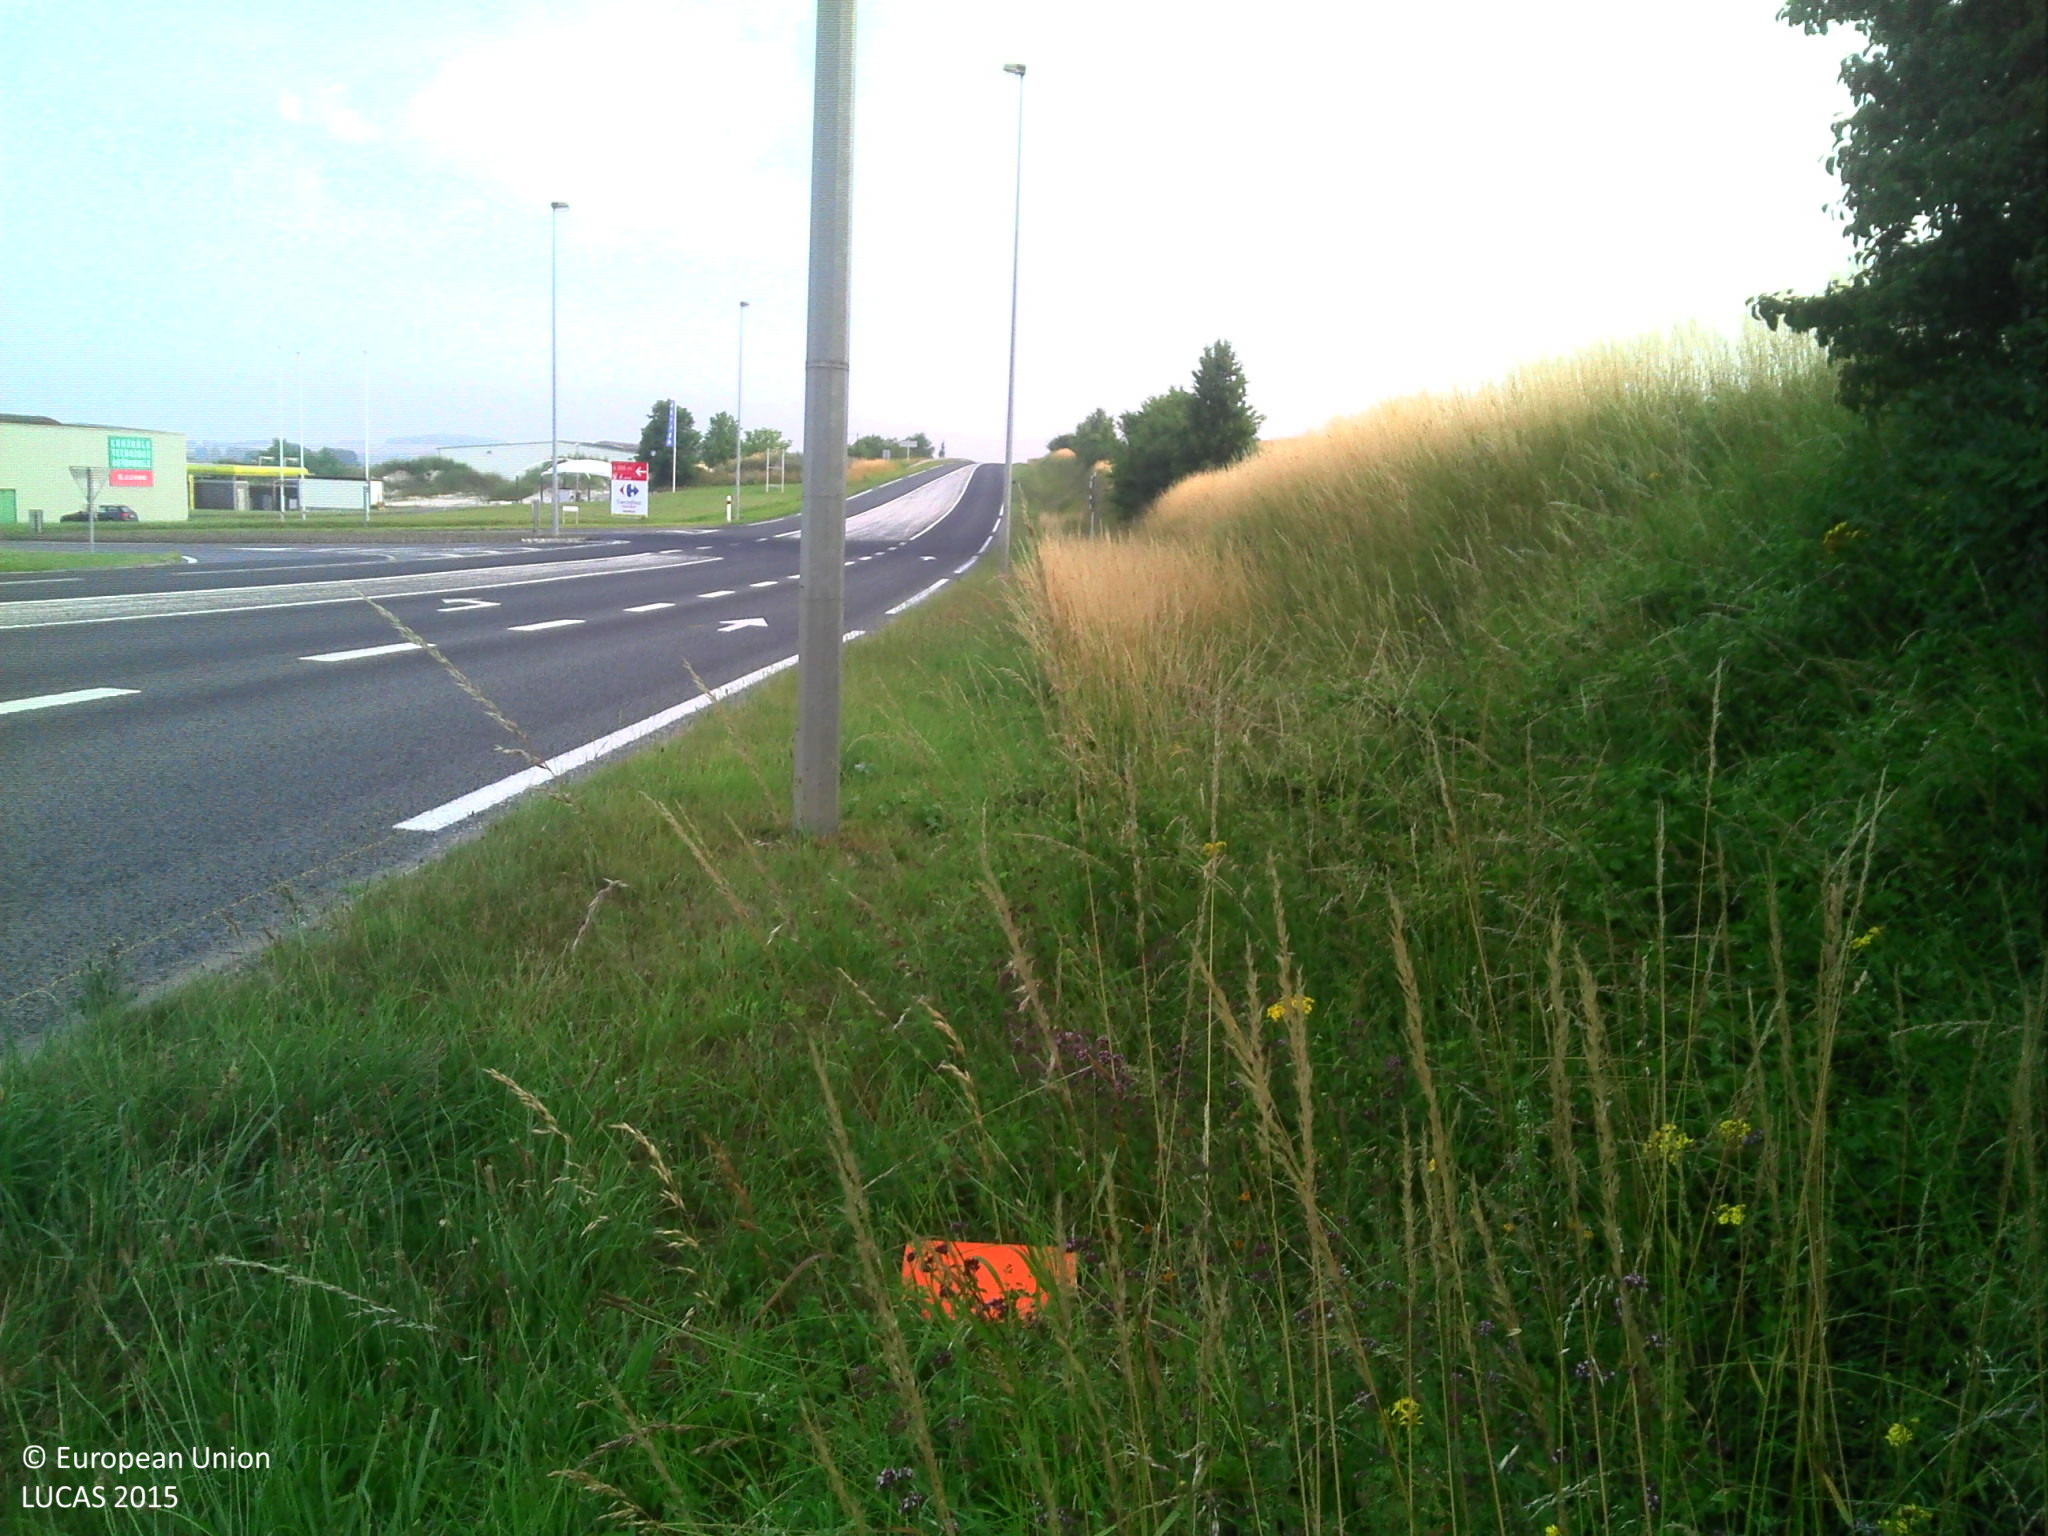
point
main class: Cropland
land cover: Common wheat
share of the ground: > 75 %
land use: Agriculture (excluding fallow land and kitchen gardens)
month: July
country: FR
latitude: 49.7908
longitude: 2.4727
